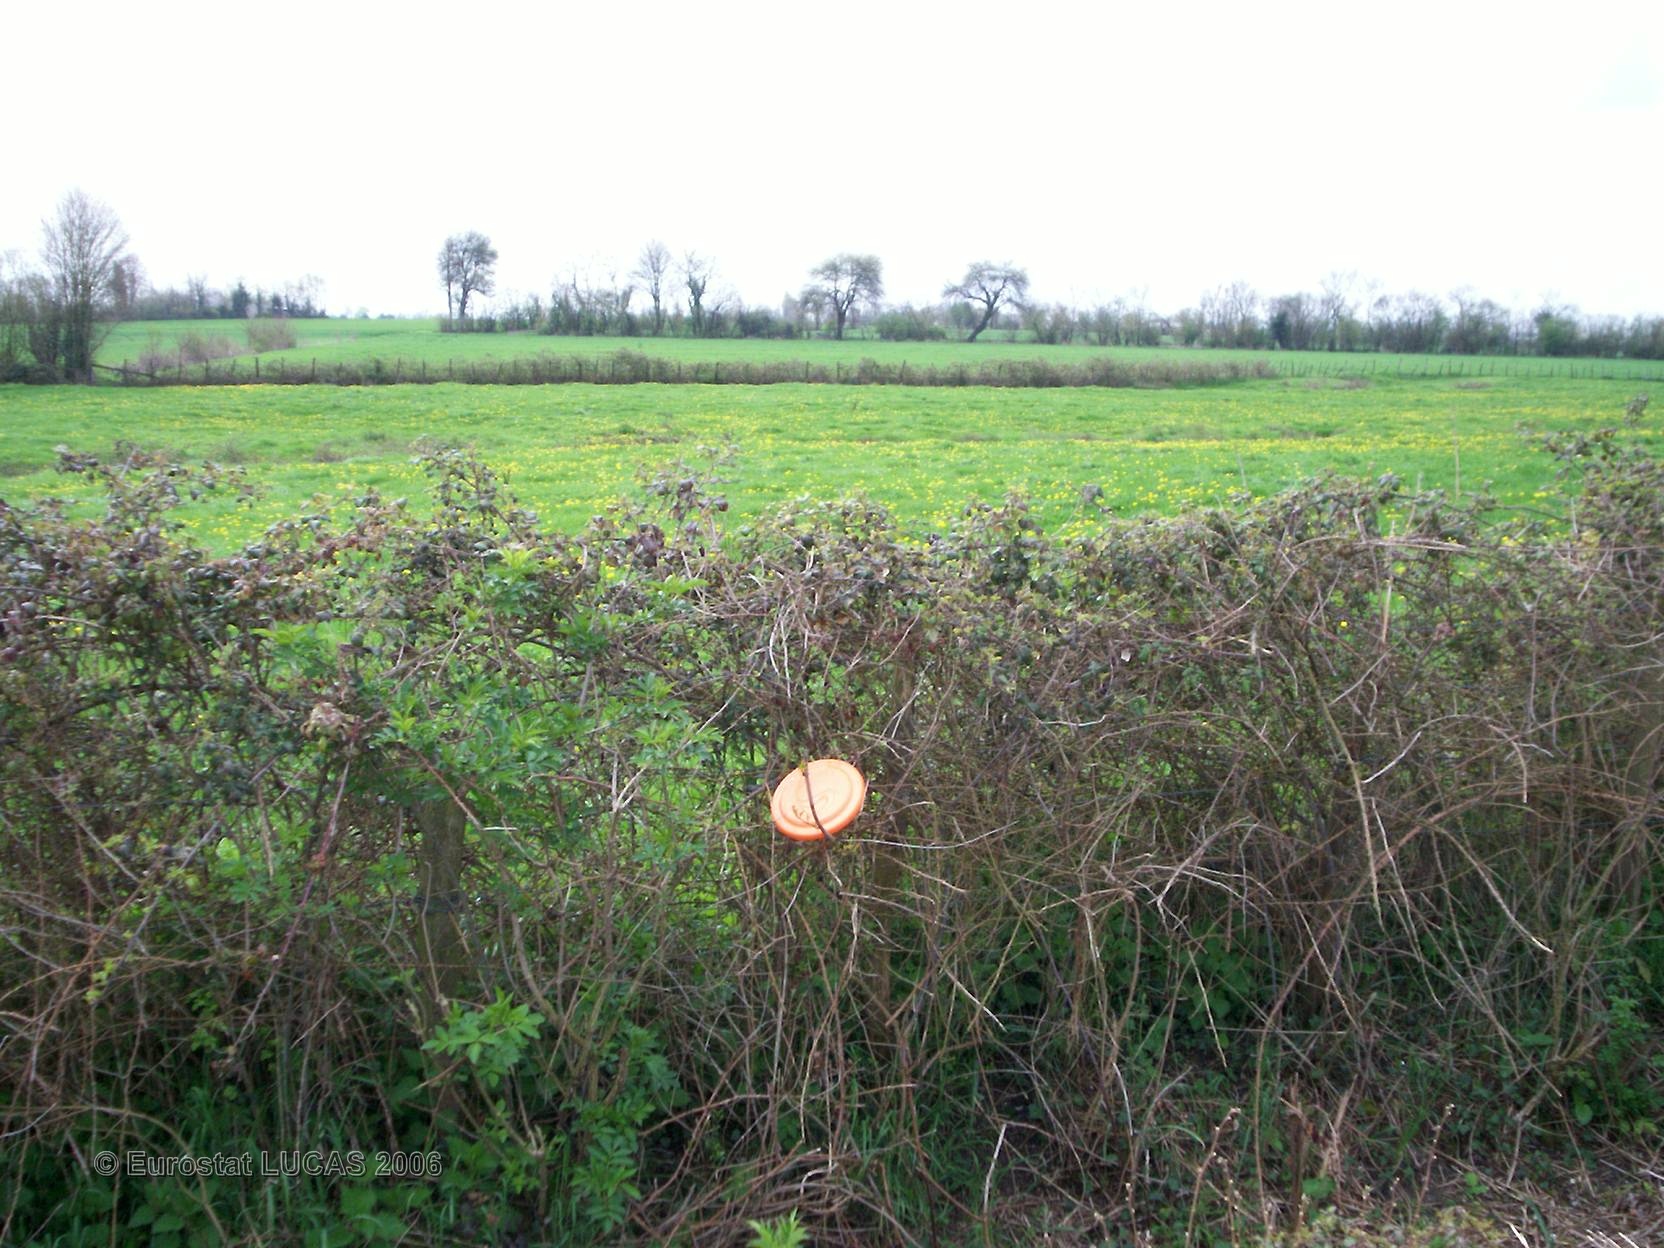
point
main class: Cropland
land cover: Sunflower
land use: Agriculture (excluding fallow land and kitchen gardens)
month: May
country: FR
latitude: 47.5261
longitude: 0.1334
